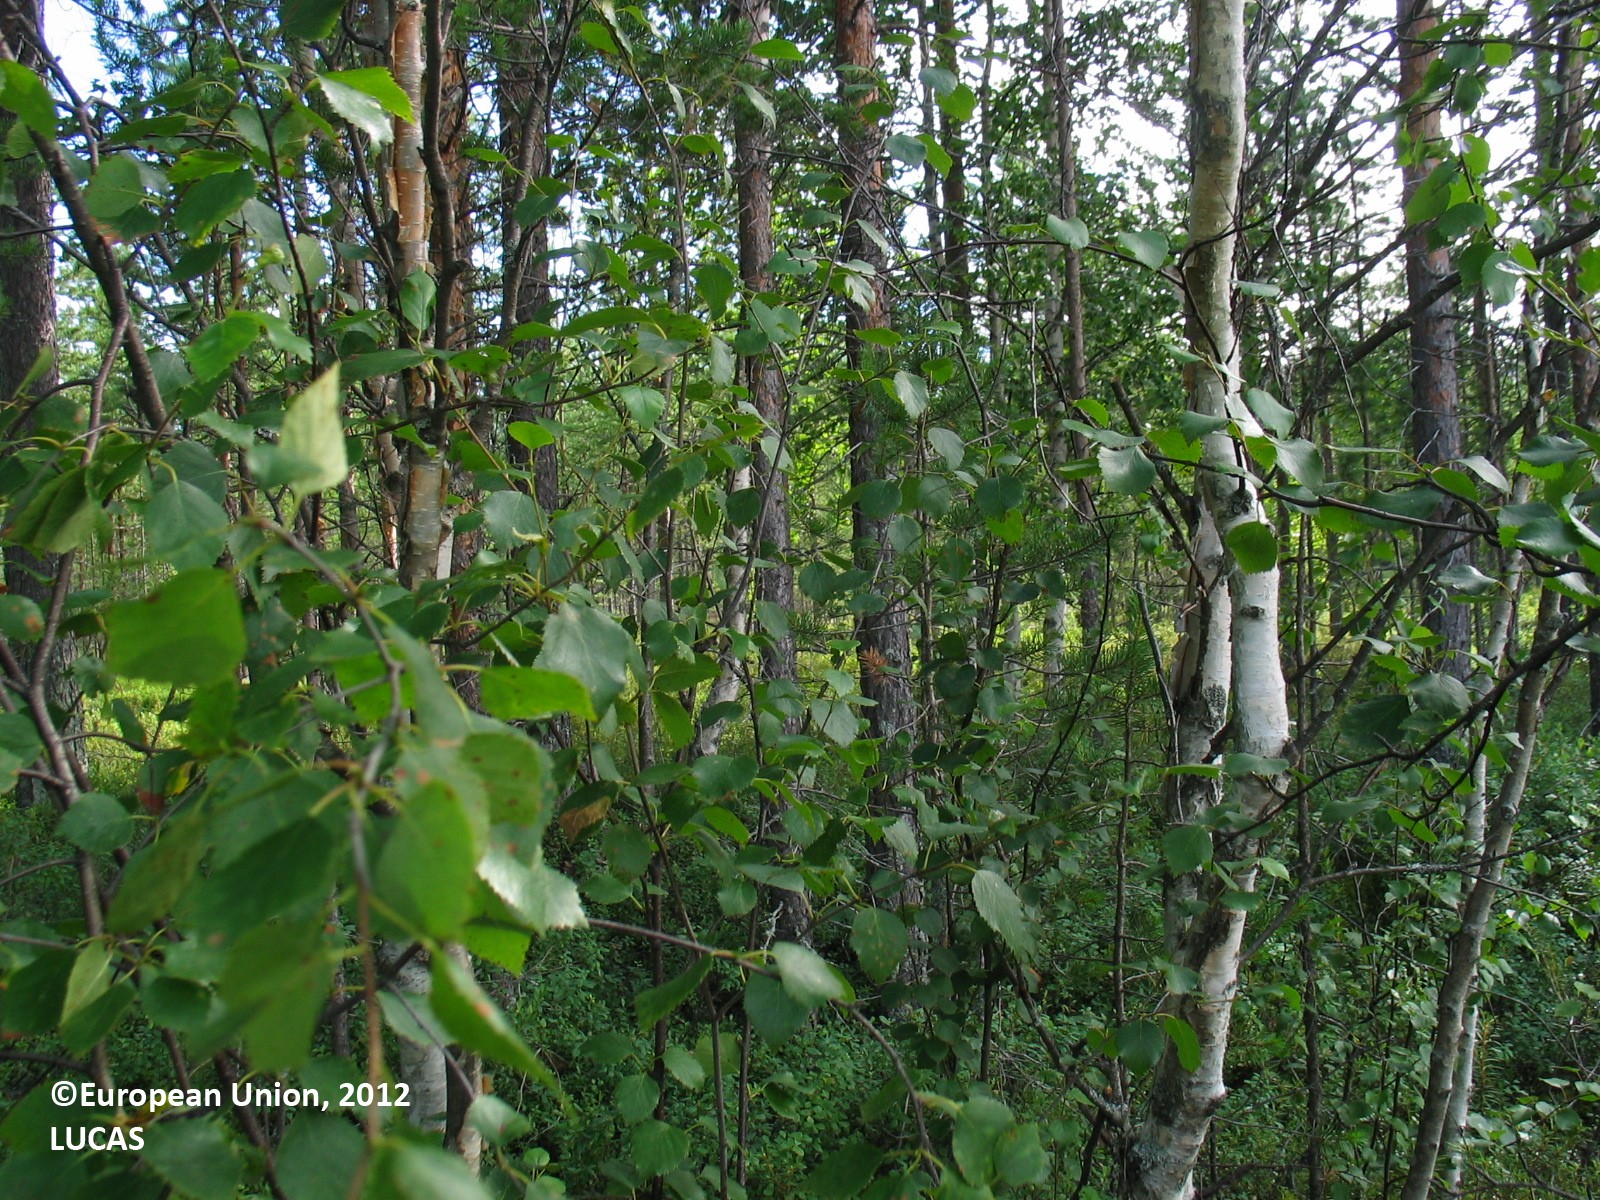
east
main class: Woodland
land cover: Other mixed woodland
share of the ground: 50 - 75 %
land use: Forestry
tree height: > 5 m
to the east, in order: Other mixed woodland; Pine dominated coniferous woodland; Tracks; Pine dominated coniferous woodland
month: July
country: FI
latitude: 64.6685
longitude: 26.3856
